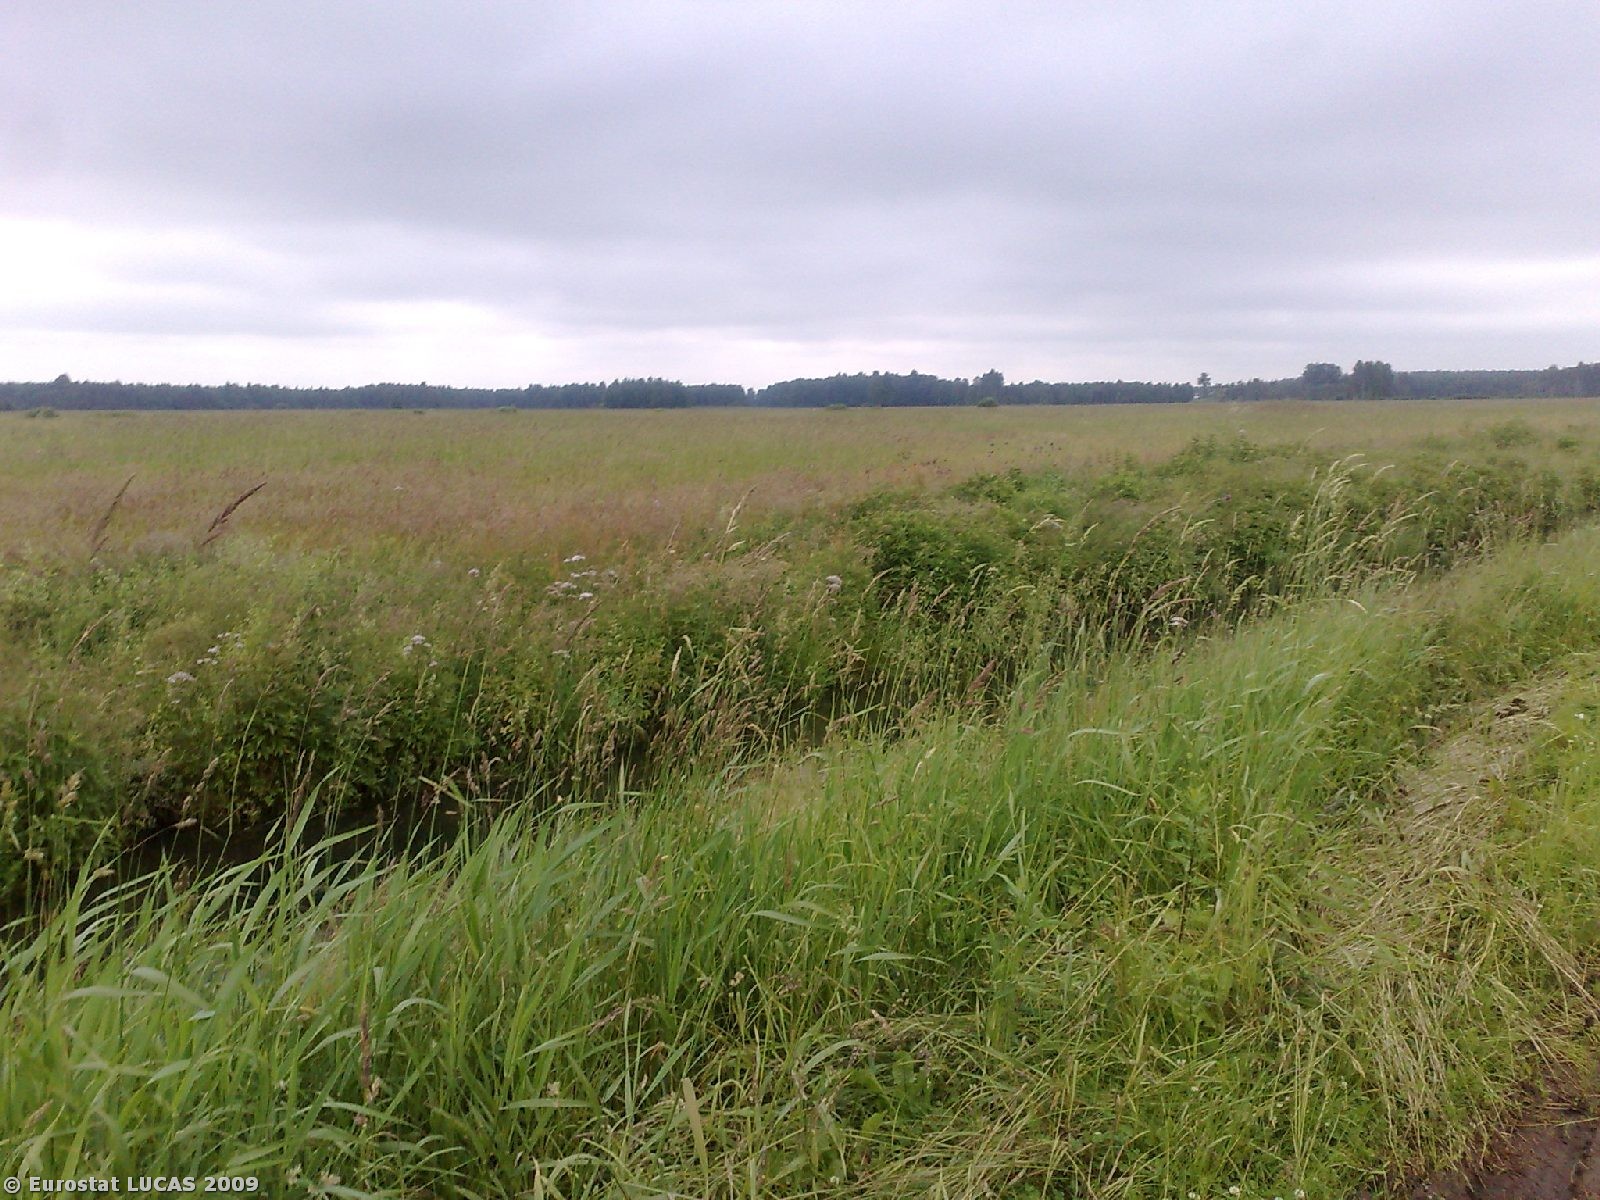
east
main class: Grassland
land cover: Grassland without tree/shrub cover
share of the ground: > 75 %
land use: Agriculture (excluding fallow land and kitchen gardens)
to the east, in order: Grassland without tree/shrub cover
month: June
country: PL
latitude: 53.7251
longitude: 23.4344
